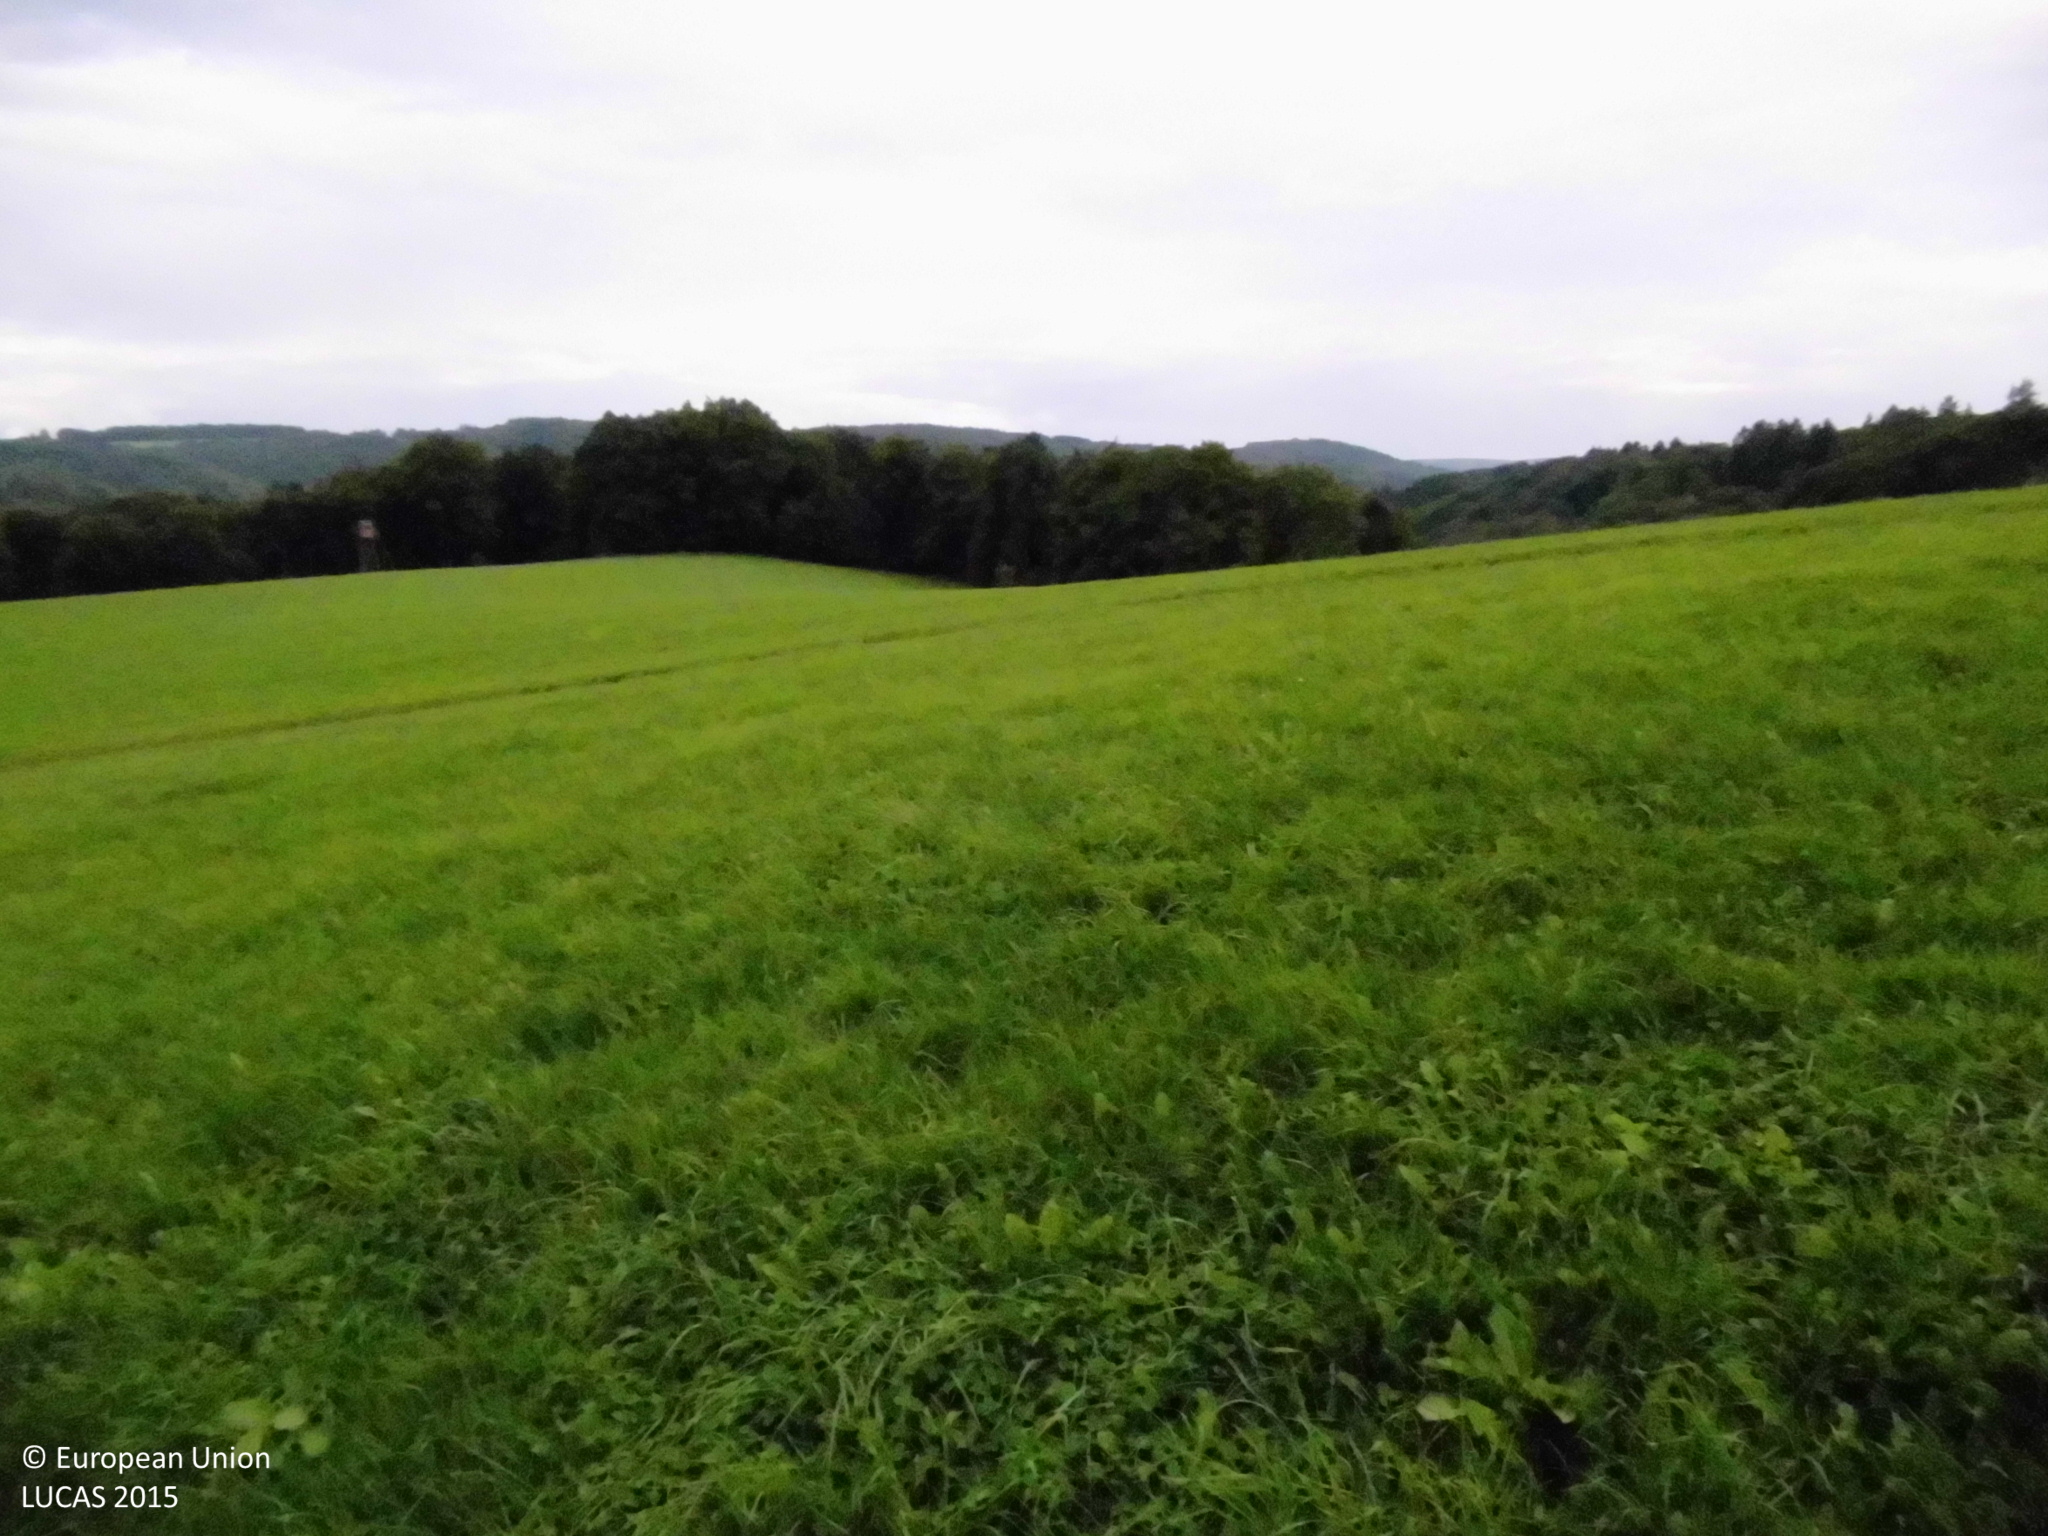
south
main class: Grassland
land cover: Grassland without tree/shrub cover
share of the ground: > 75 %
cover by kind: herbaceous plants 100 %
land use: Agriculture (excluding fallow land and kitchen gardens)
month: September
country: DE
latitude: 50.5514
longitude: 7.4456
